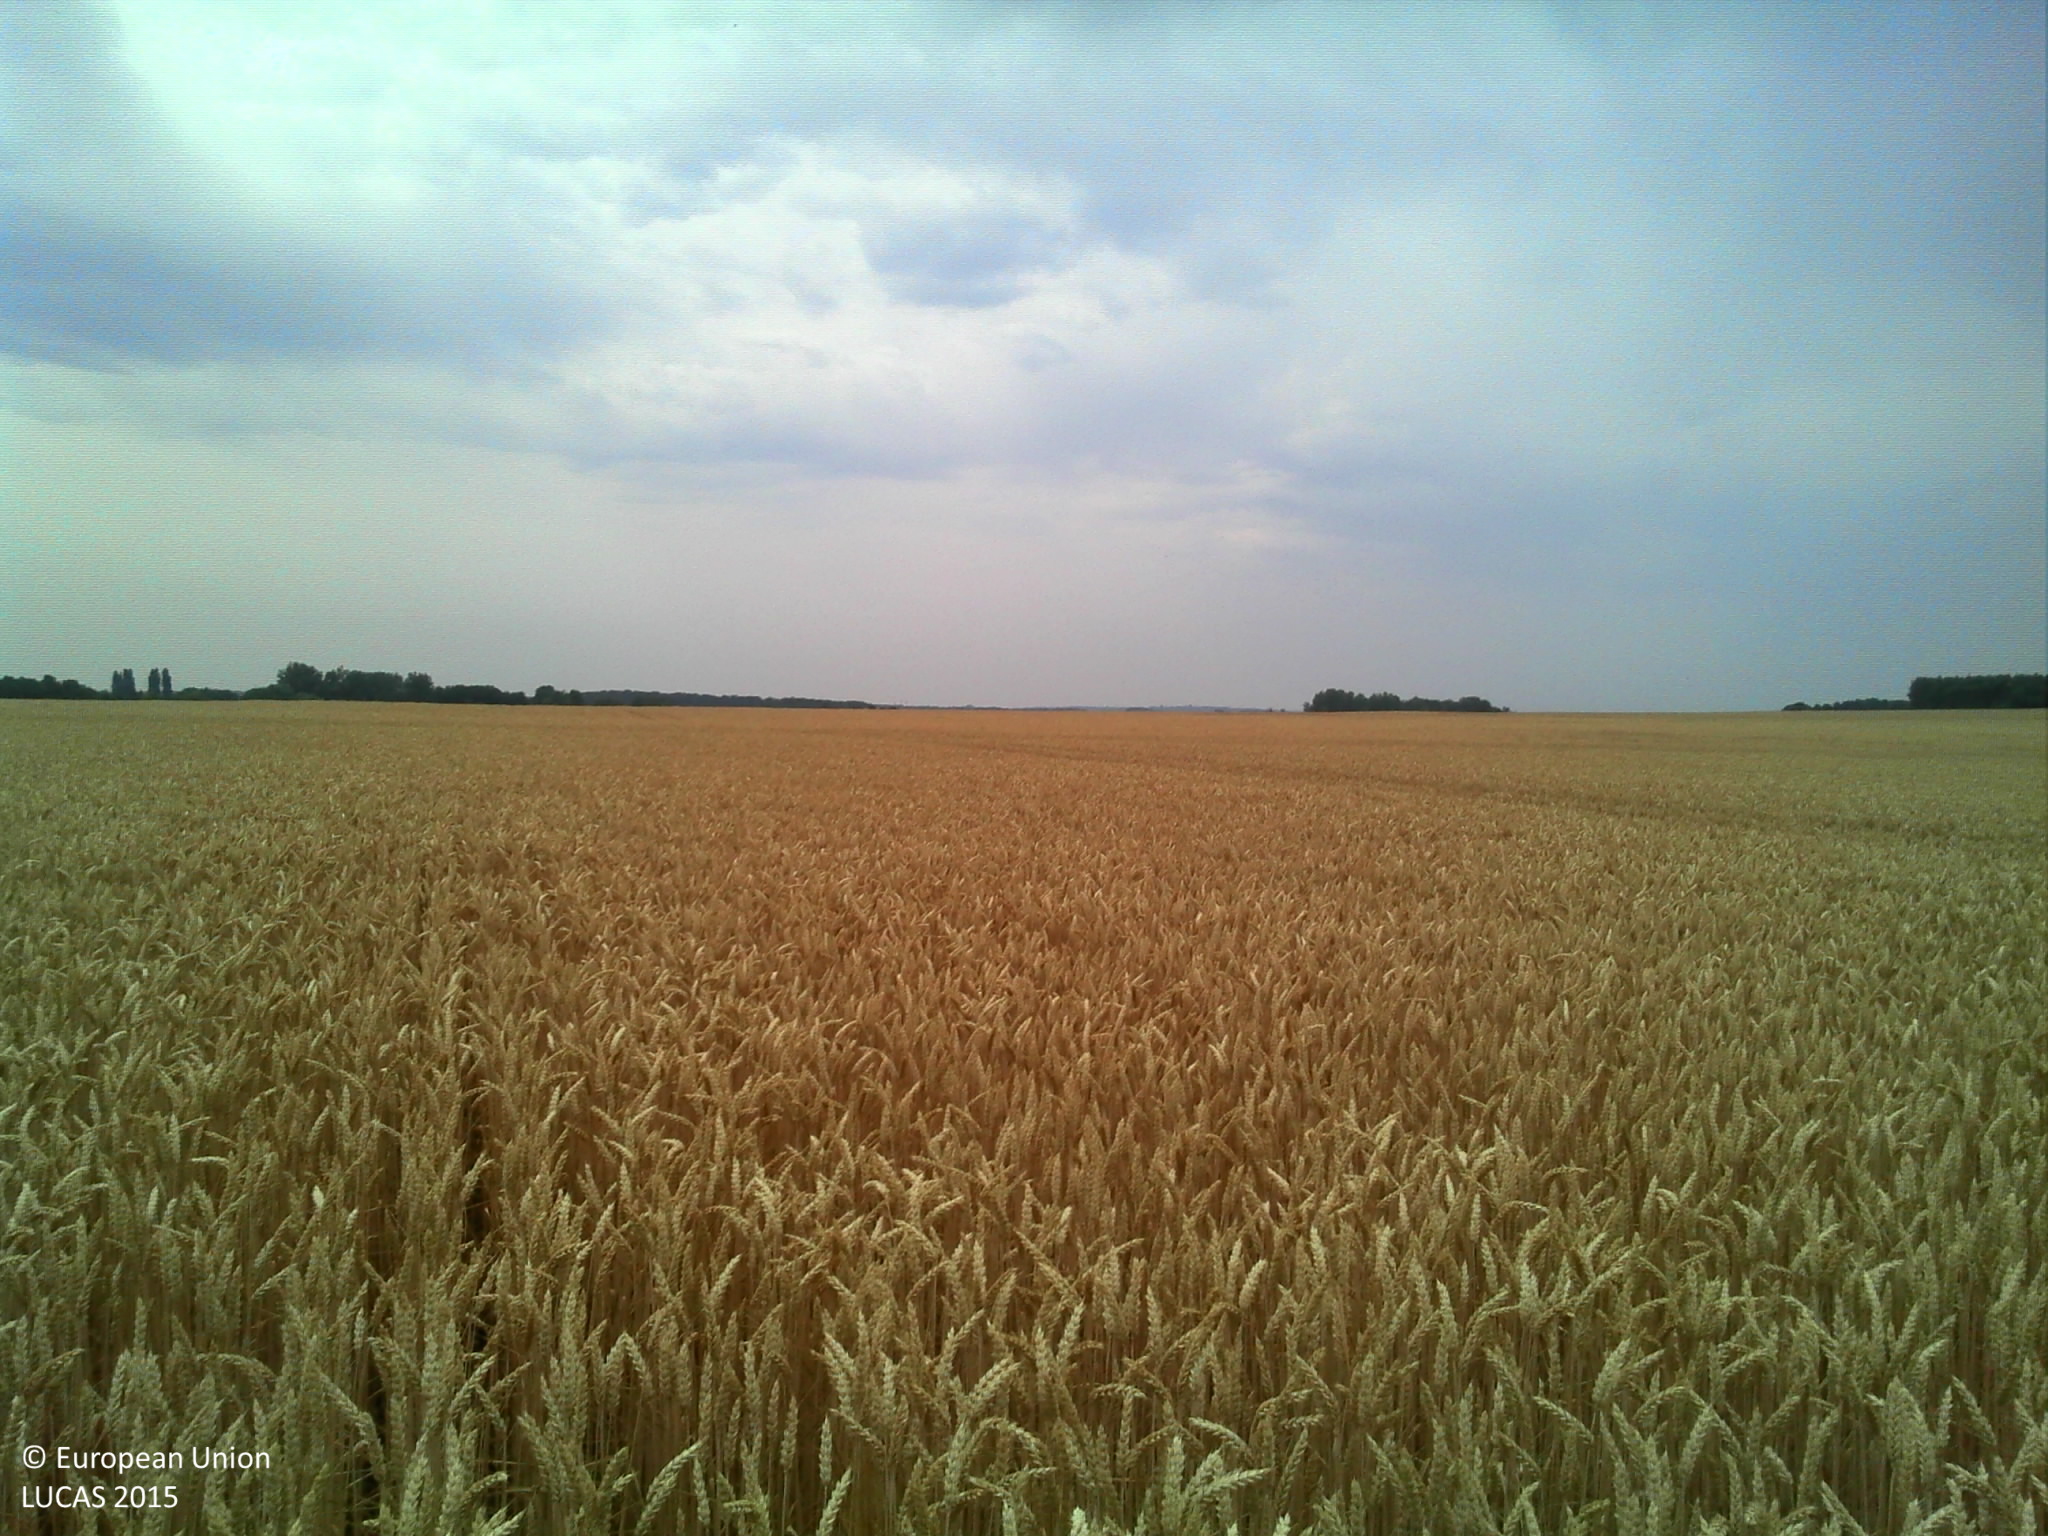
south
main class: Cropland
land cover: Common wheat
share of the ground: > 75 %
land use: Agriculture (excluding fallow land and kitchen gardens)
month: July
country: FR
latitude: 47.9323
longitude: 2.7775
